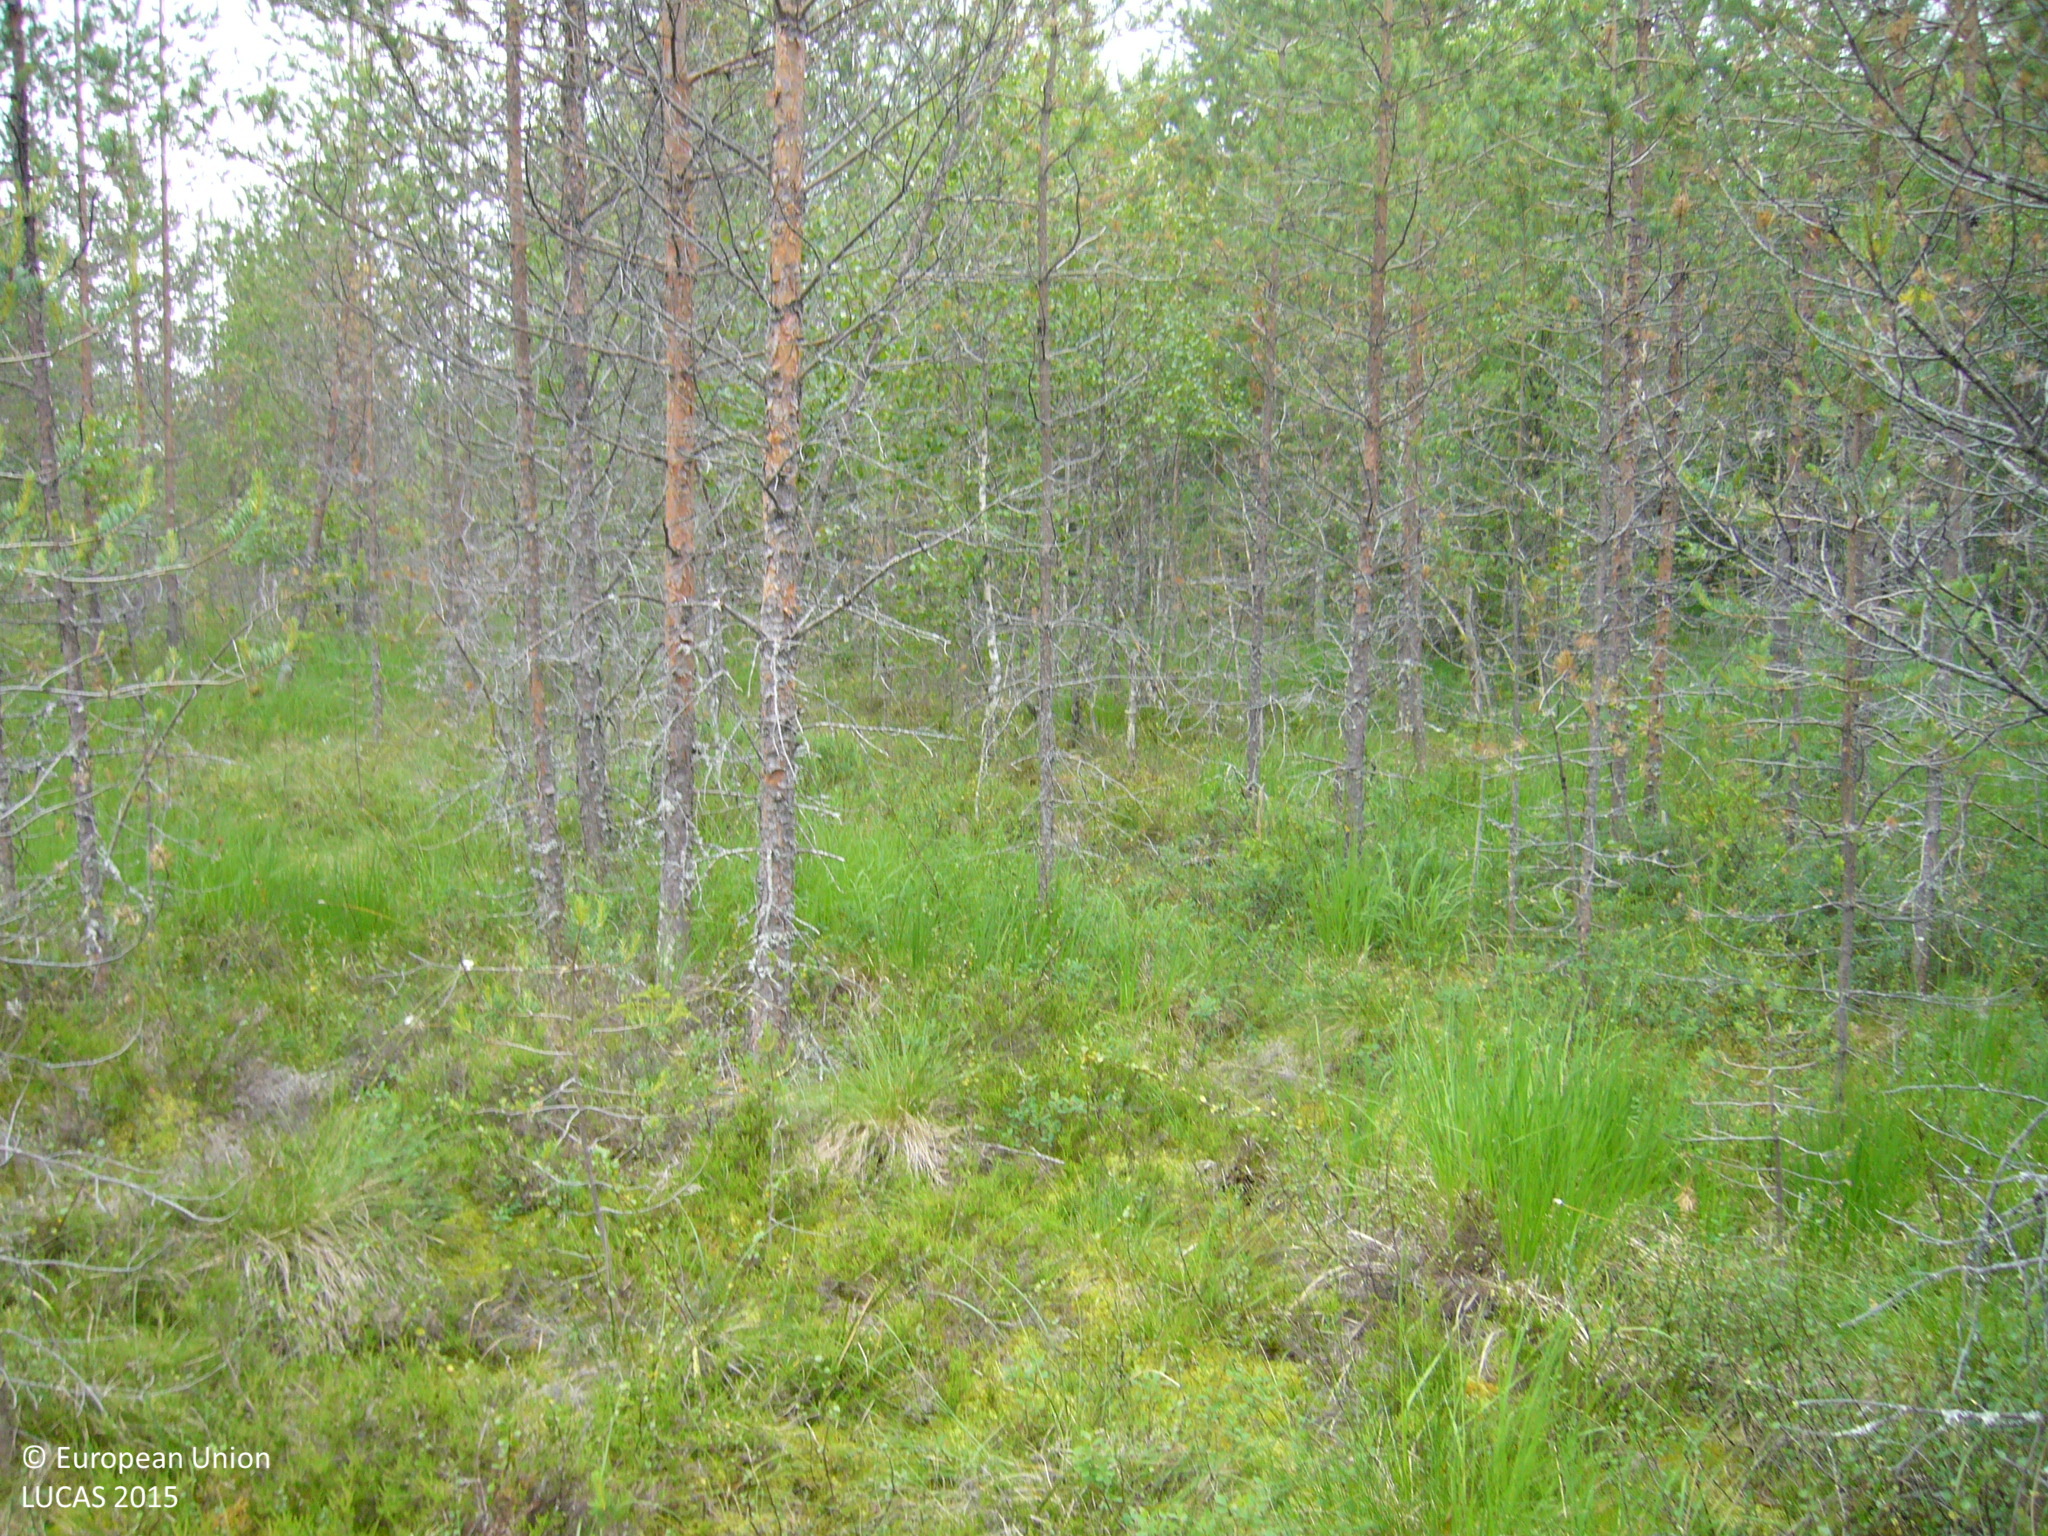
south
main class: Woodland
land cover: Pine dominated coniferous woodland
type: mire and swamp forests
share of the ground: 25 - 50 %
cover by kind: shrubs 60 %, coniferous forest trees 30 %, broadleaved forest trees 10 %
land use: Forestry
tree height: > 5 m
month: July
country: FI
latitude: 63.7797
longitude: 25.6617
